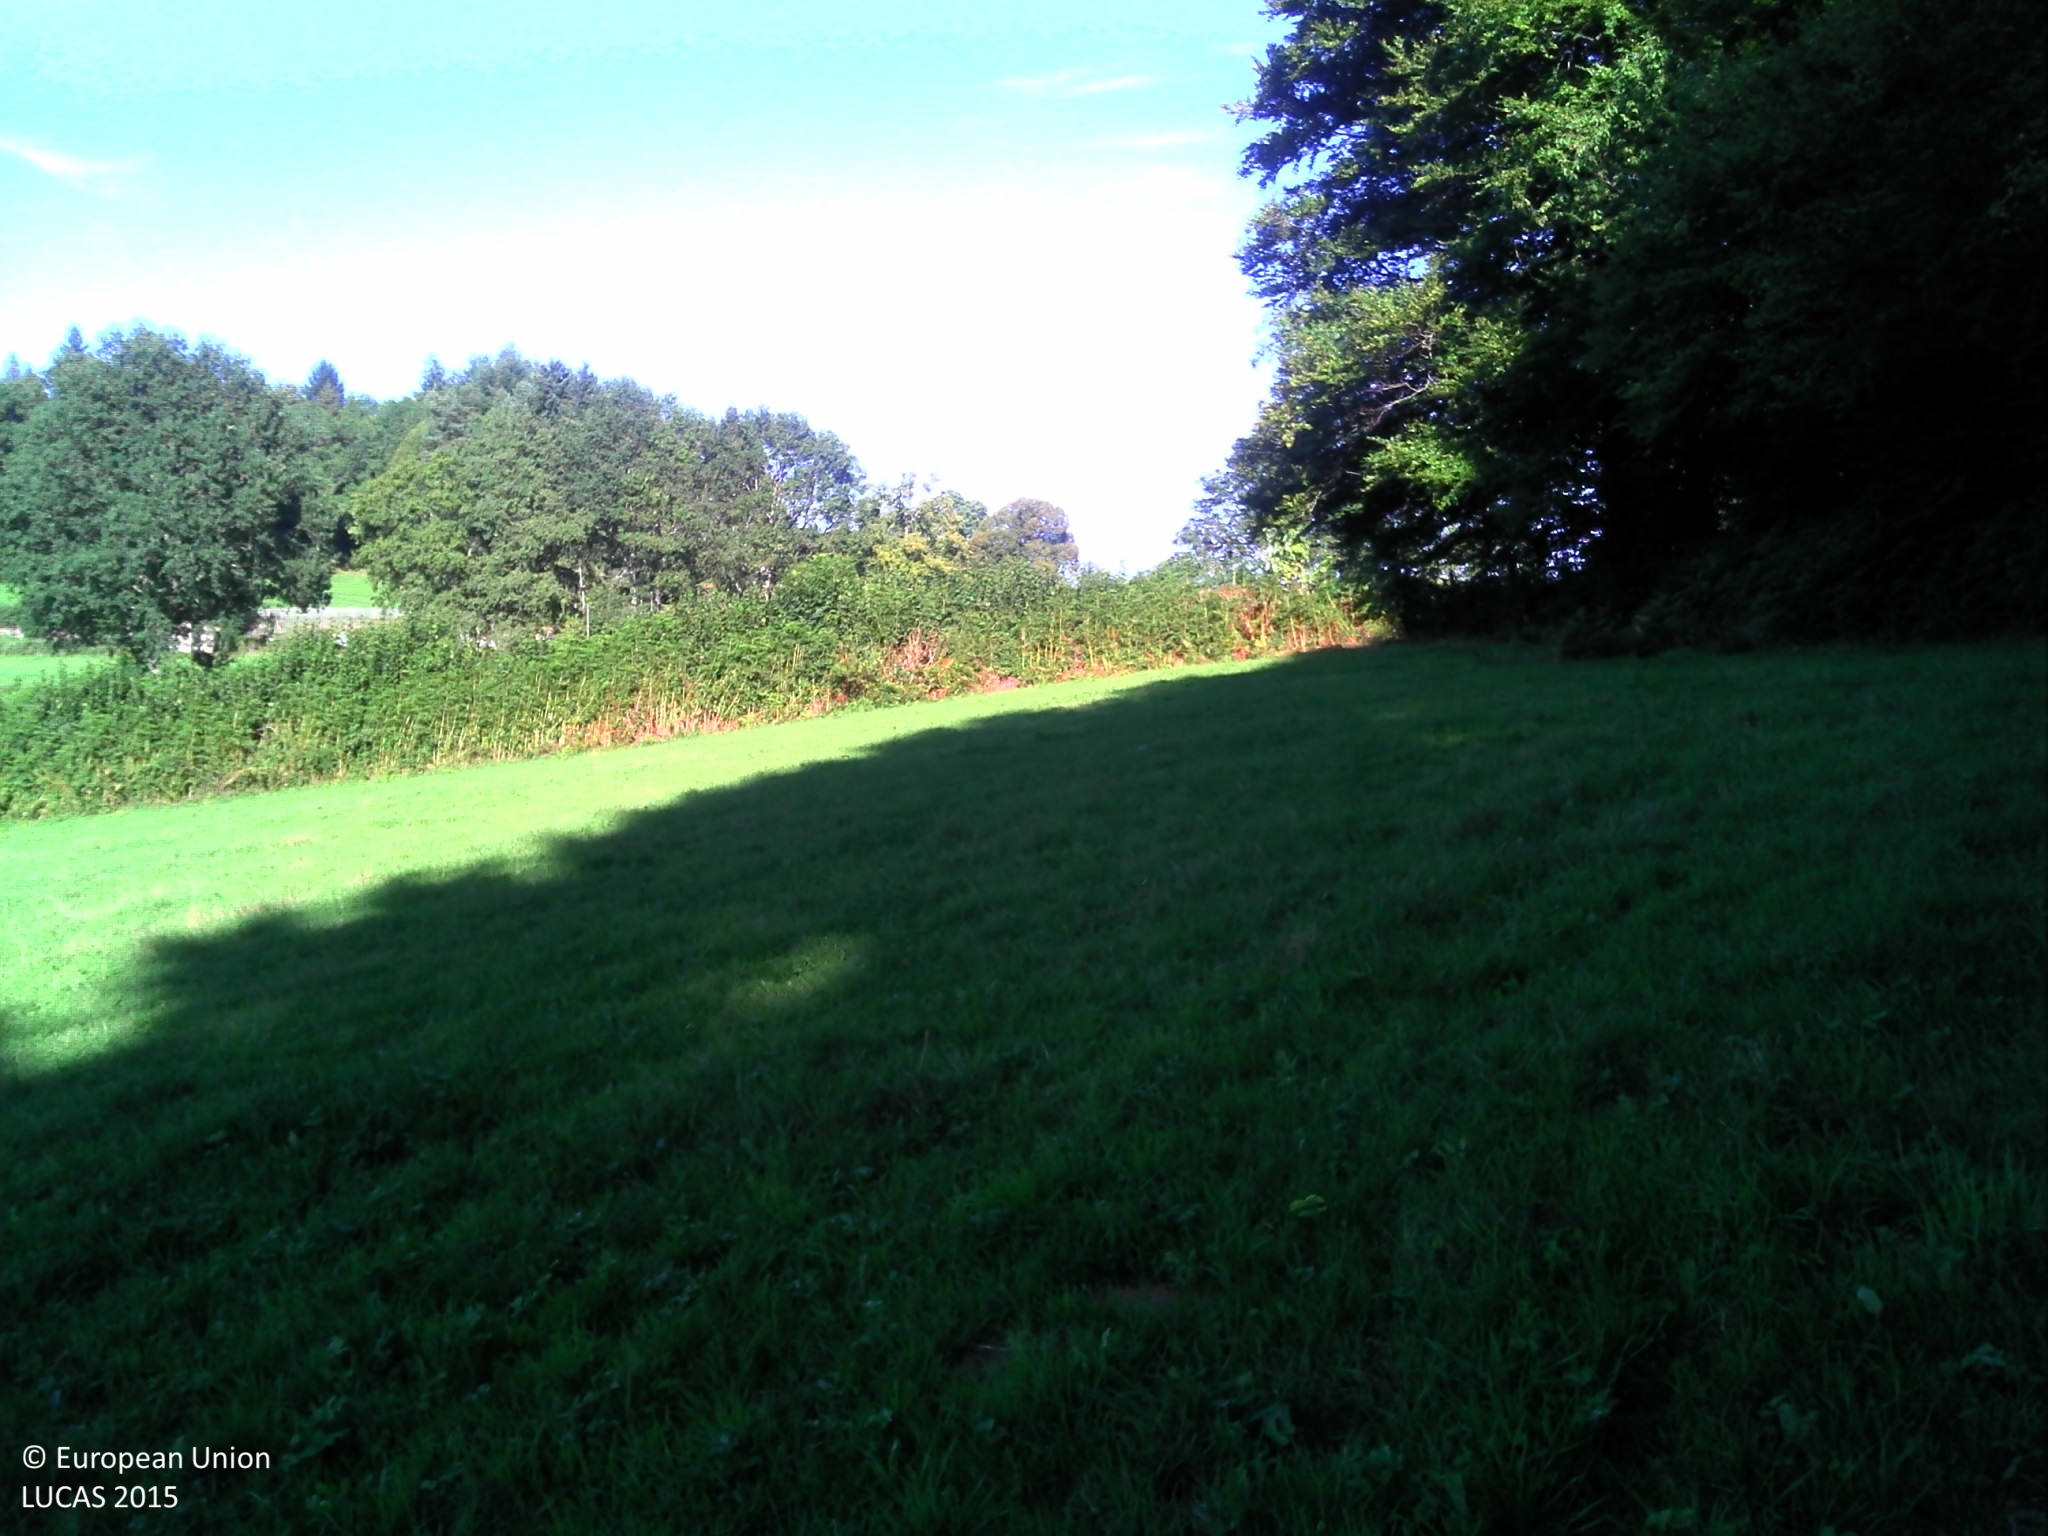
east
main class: Grassland
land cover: Grassland without tree/shrub cover
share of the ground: > 75 %
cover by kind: herbaceous plants 100 %
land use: Agriculture (excluding fallow land and kitchen gardens)
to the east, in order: Grassland without tree/shrub cover; Managed hedges; Fences; Grassland without tree/shrub cover; Fences; Managed hedges; Fences; Grassland without tree/shrub cover; Electric lines; Fences; Managed hedges; Grass margins; Electric lines; Paved roads, cycling and walking lanes; Grass margins; Shrubland with sparse tree cover; Artificial constructions in urban areas
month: August
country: FR
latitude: 45.8352
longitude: 2.2588
